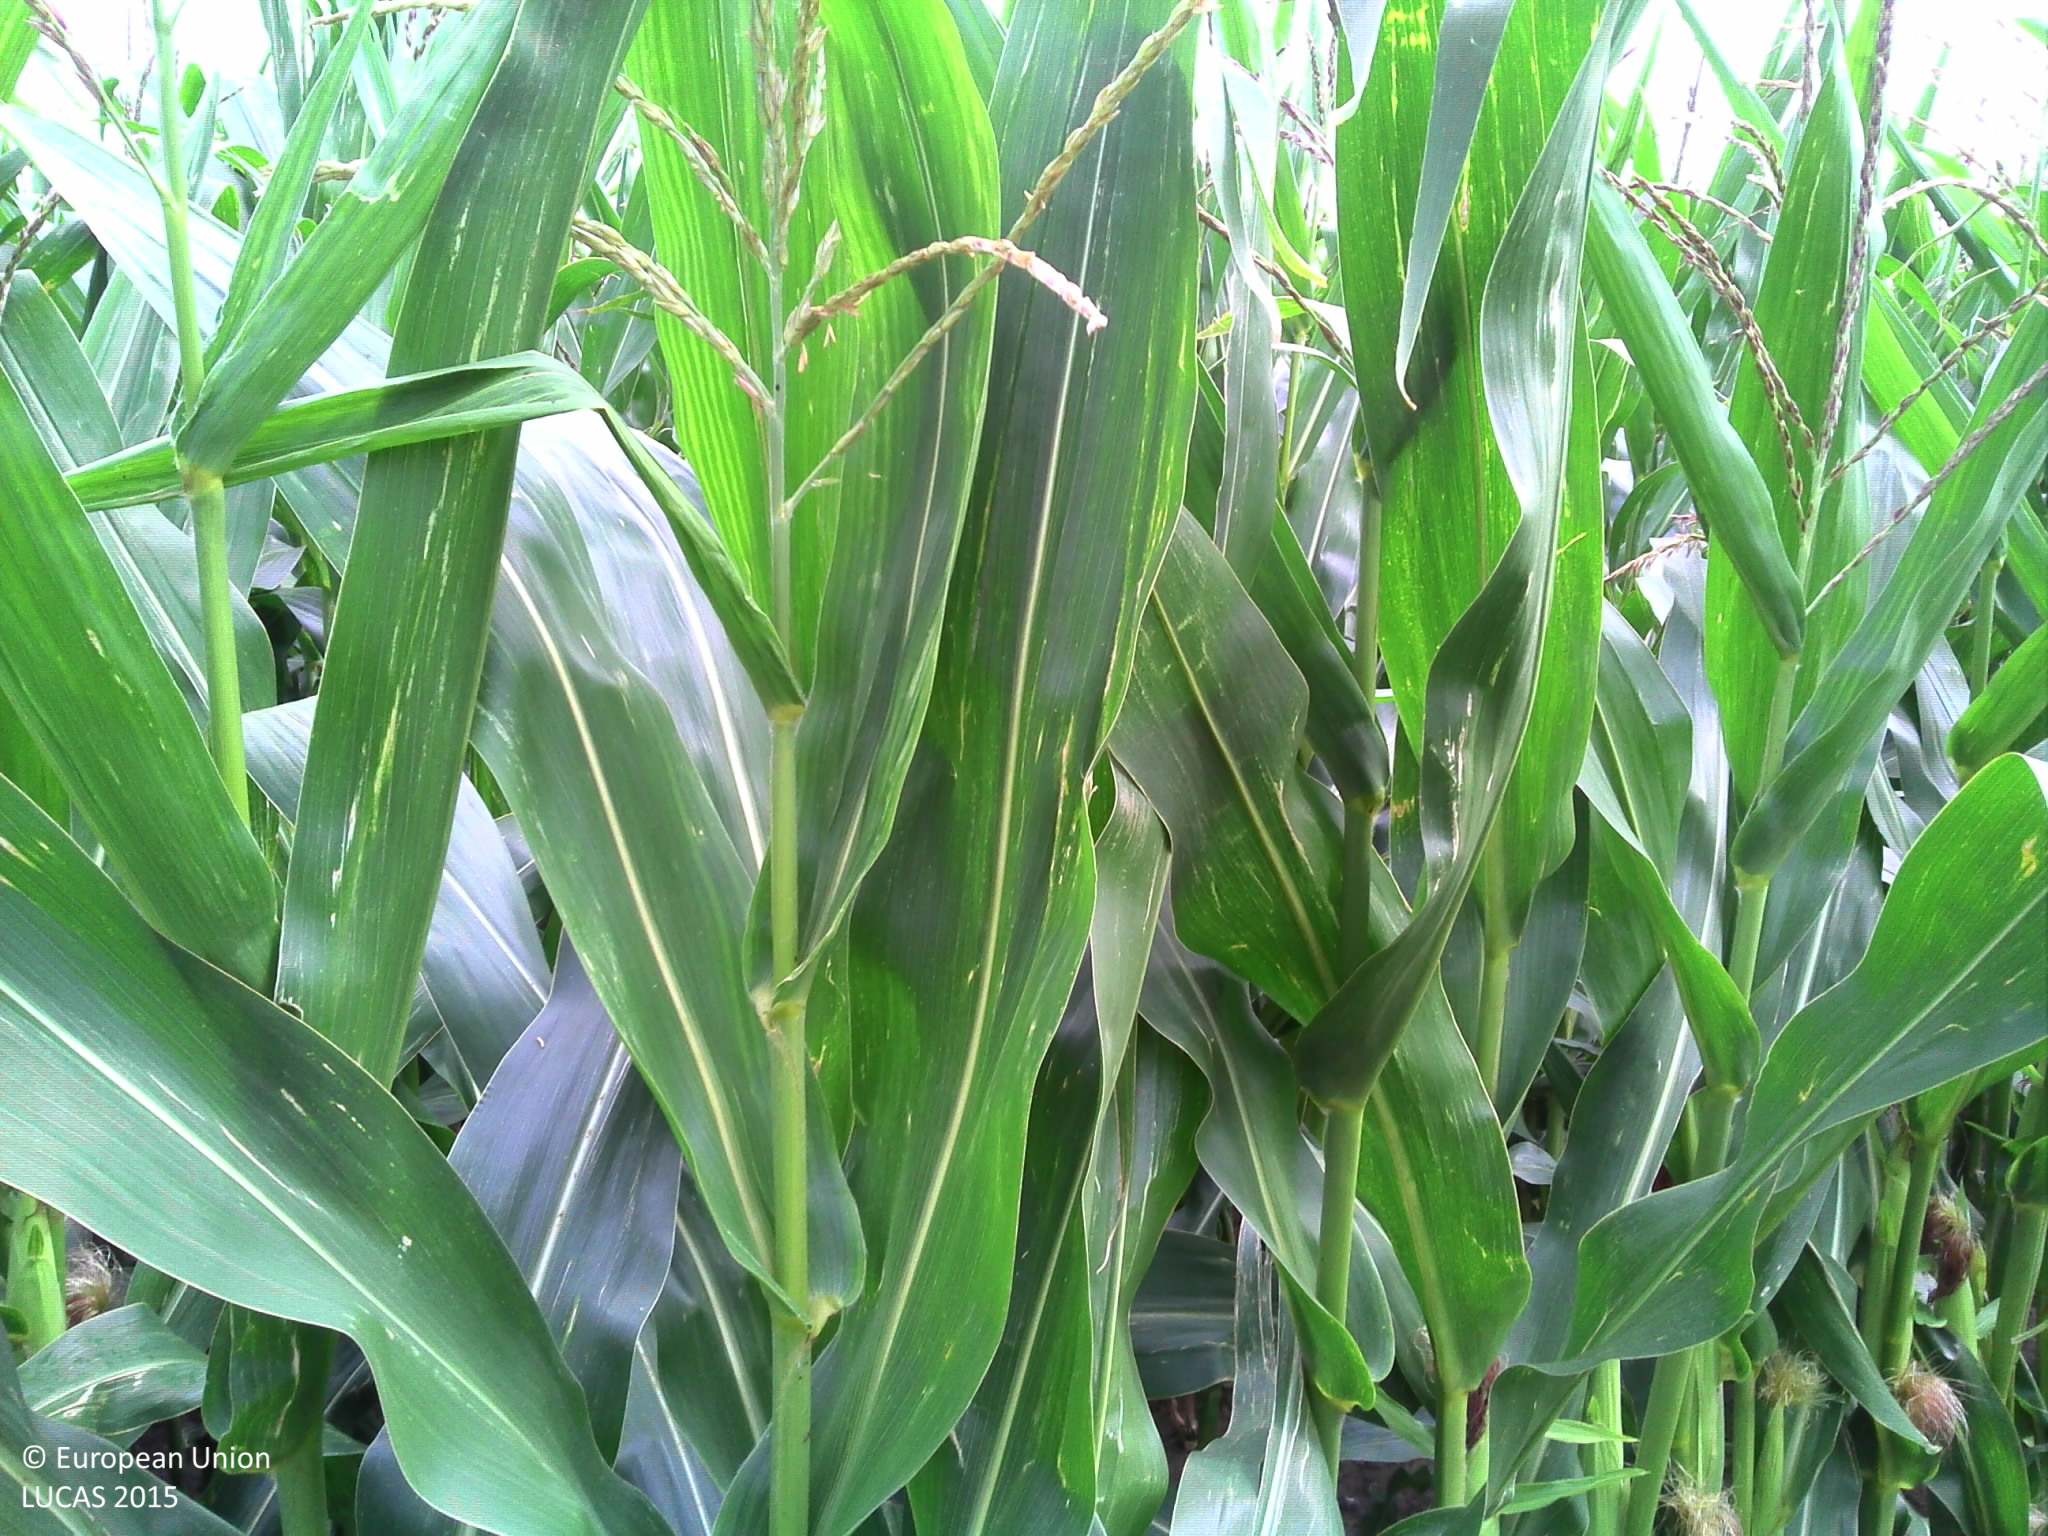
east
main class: Cropland
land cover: Temporary grasslands
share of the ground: > 75 %
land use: Agriculture (excluding fallow land and kitchen gardens)
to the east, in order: Temporary grasslands; Fences; Grass margins; Maize; Artificial constructions in urban areas; Grassland without tree/shrub cover
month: August
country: BE
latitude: 51.0255
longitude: 3.1613
